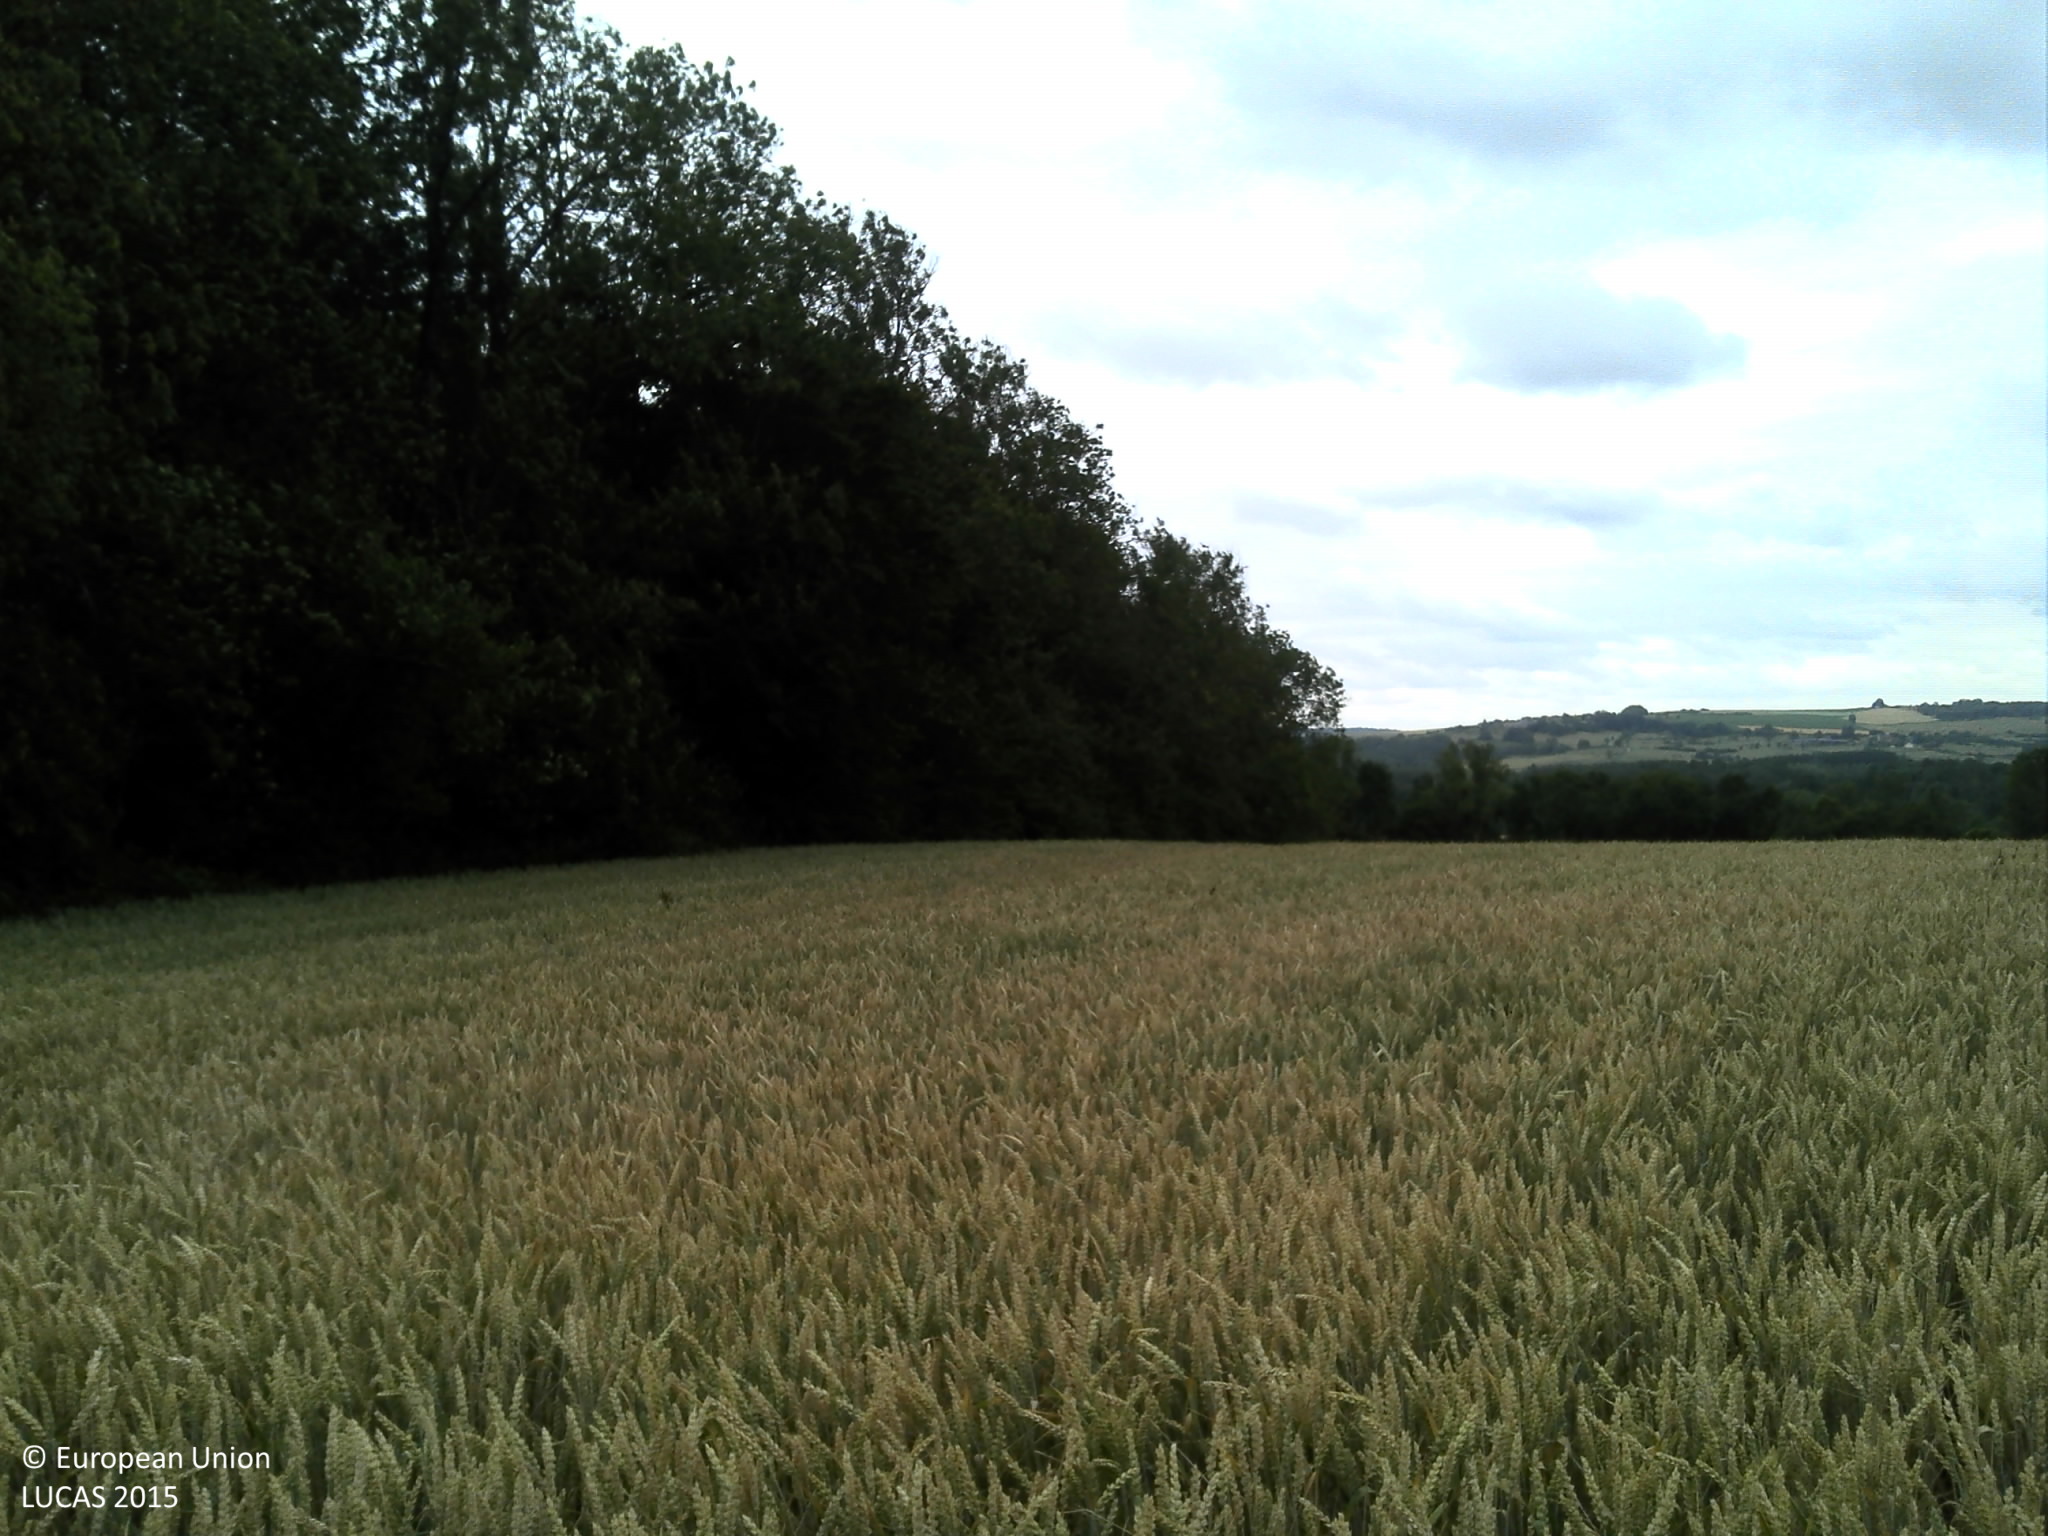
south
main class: Cropland
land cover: Common wheat
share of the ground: > 75 %
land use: Agriculture (excluding fallow land and kitchen gardens)
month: July
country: FR
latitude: 49.8202
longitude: 4.5617
